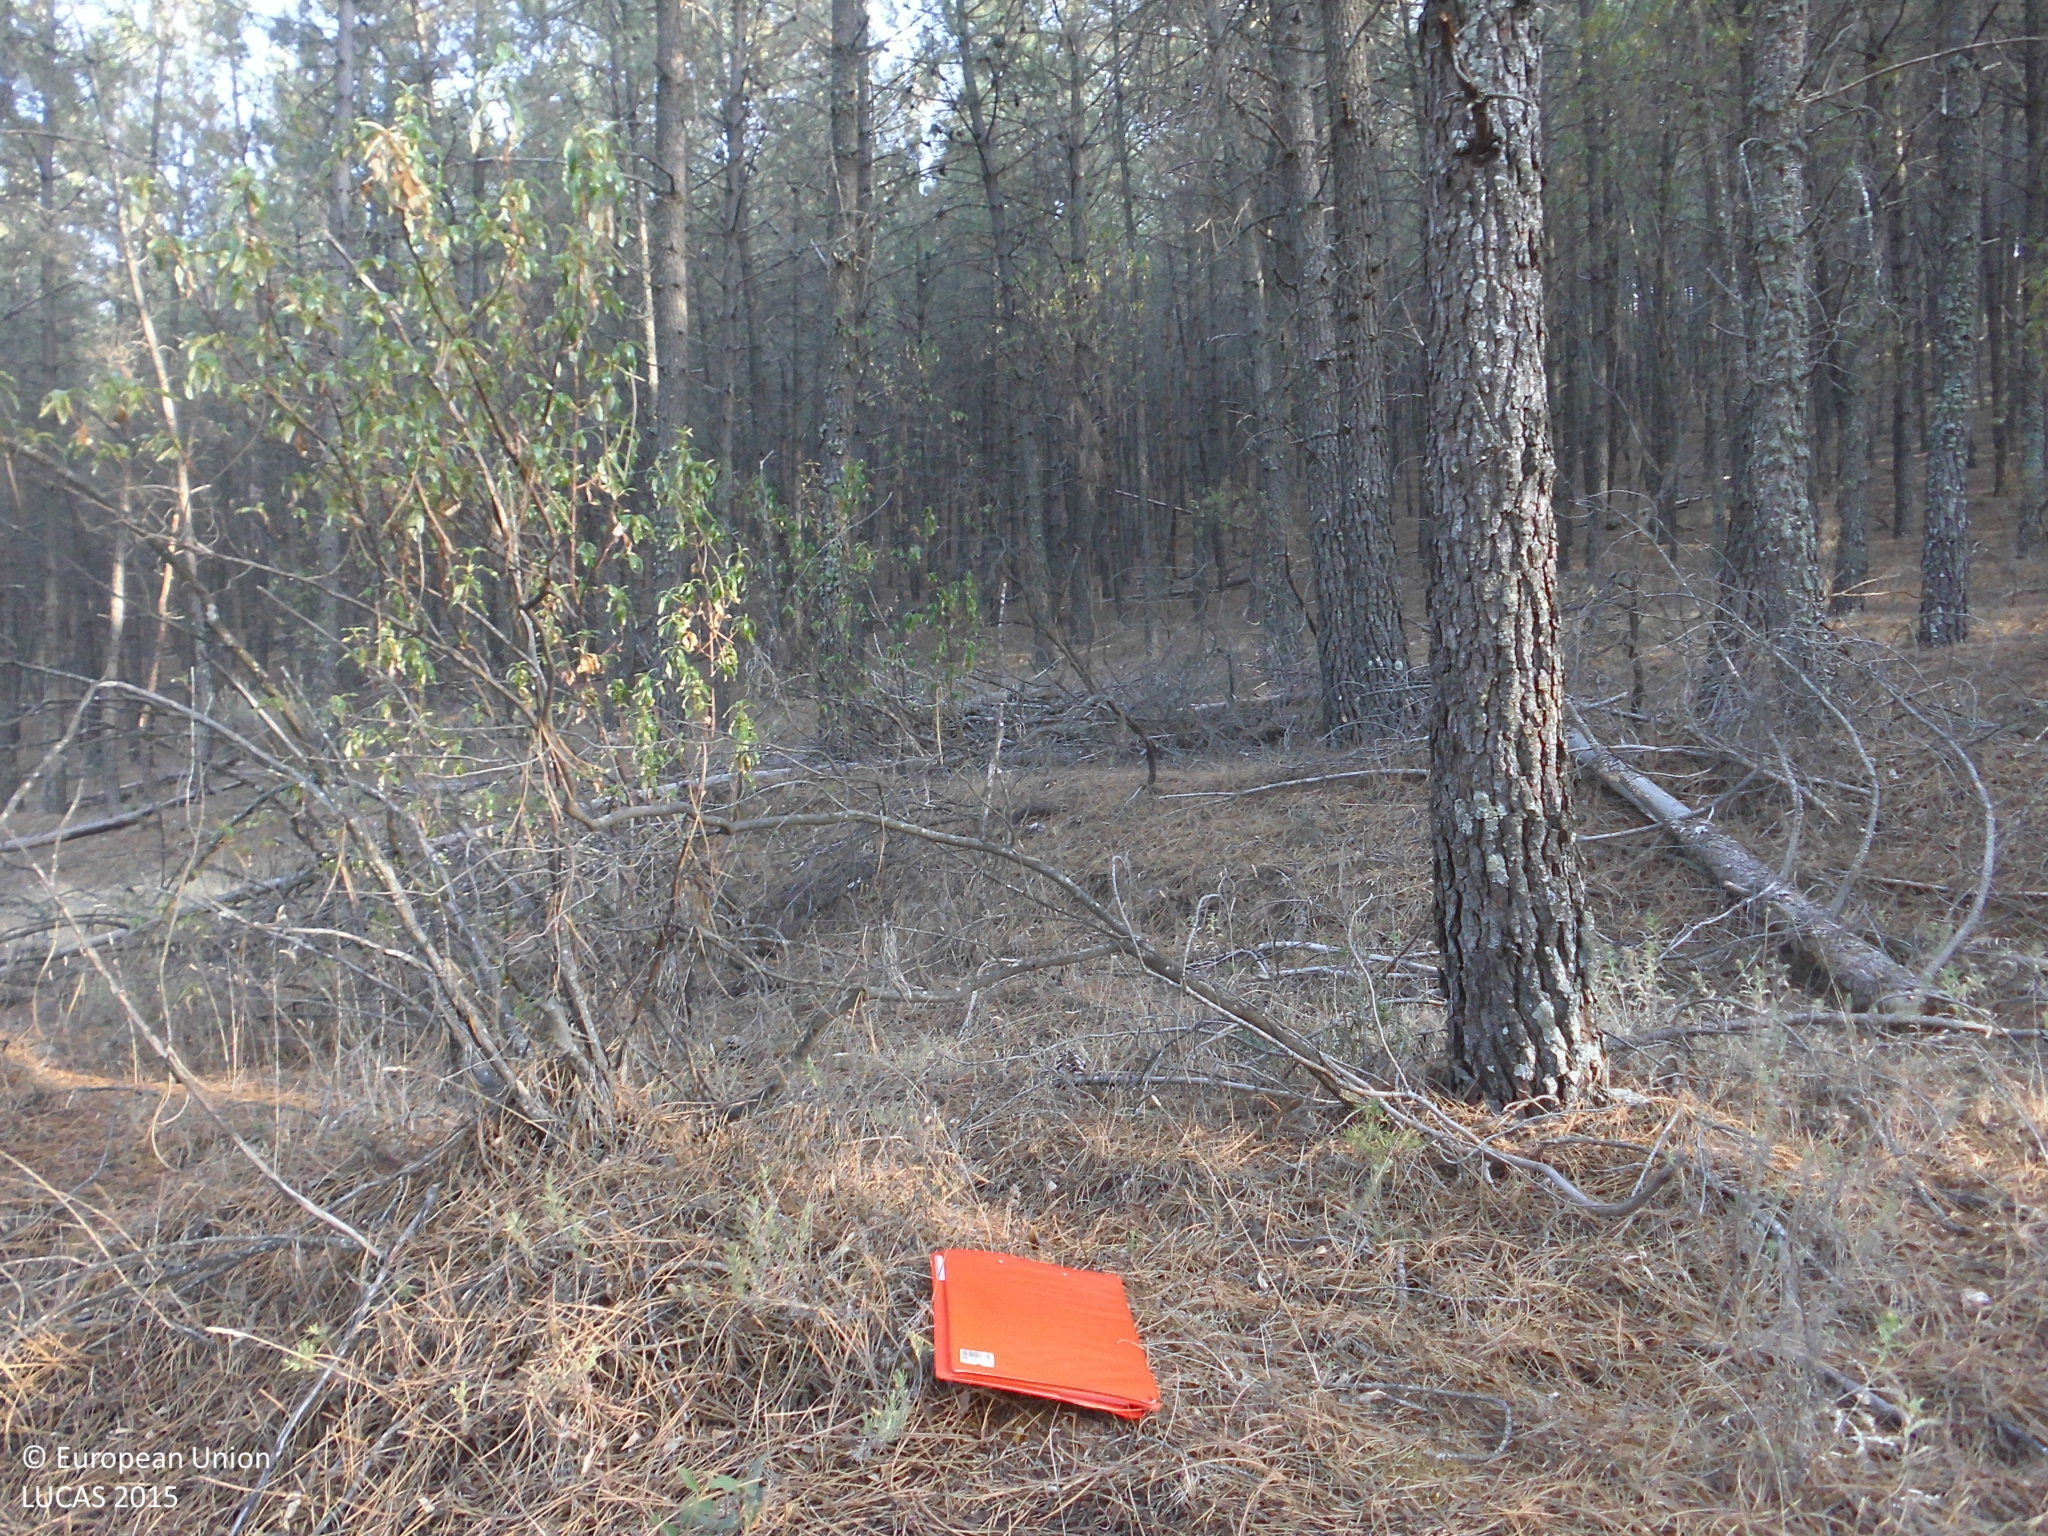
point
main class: Woodland
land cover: Pine dominated coniferous woodland
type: coniferous forest of the mediterranean region
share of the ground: > 75 %
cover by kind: coniferous forest trees 85 %, shrubs 10 %, herbaceous plants 5 %
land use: Forestry
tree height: > 5 m
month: July
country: ES
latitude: 39.7227
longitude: -5.6323
